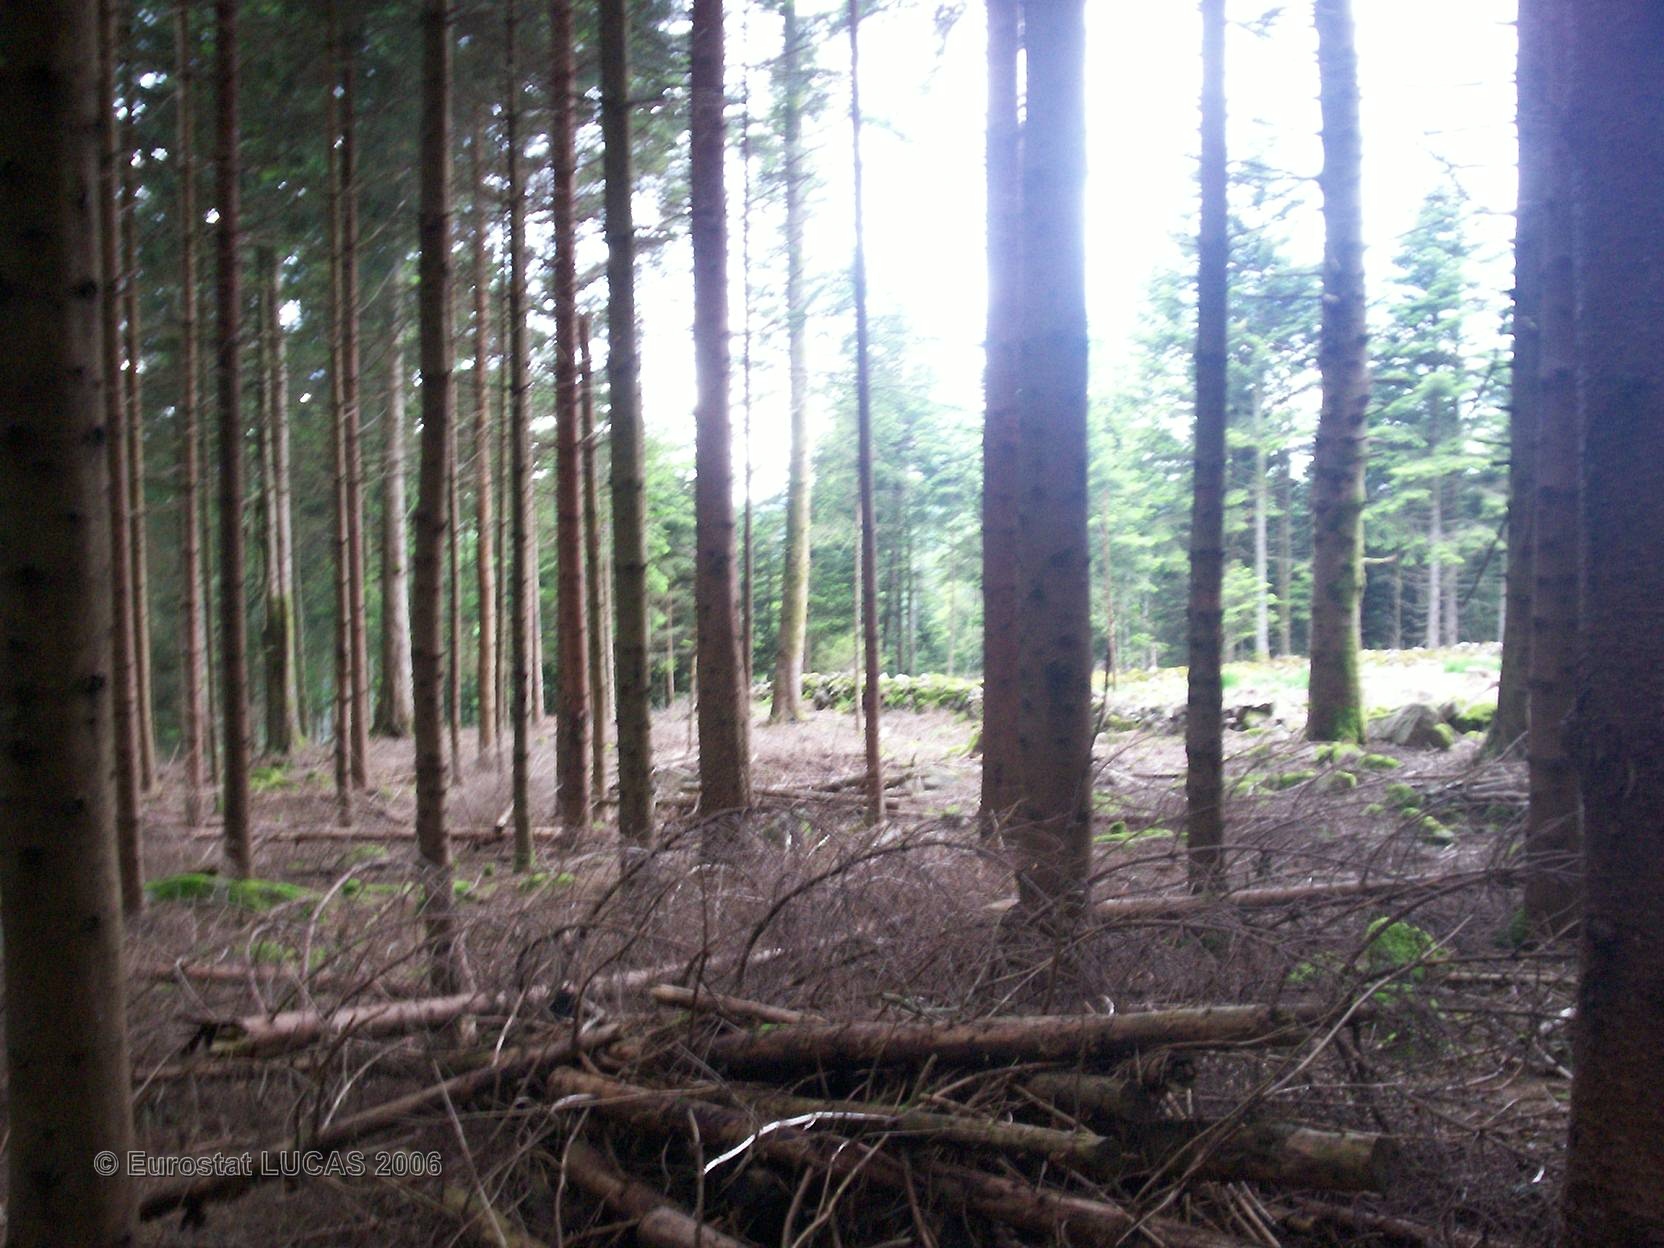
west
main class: Woodland
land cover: Coniferous forest
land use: Forestry
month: June
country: FR
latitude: 48.1041
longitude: 6.7645
